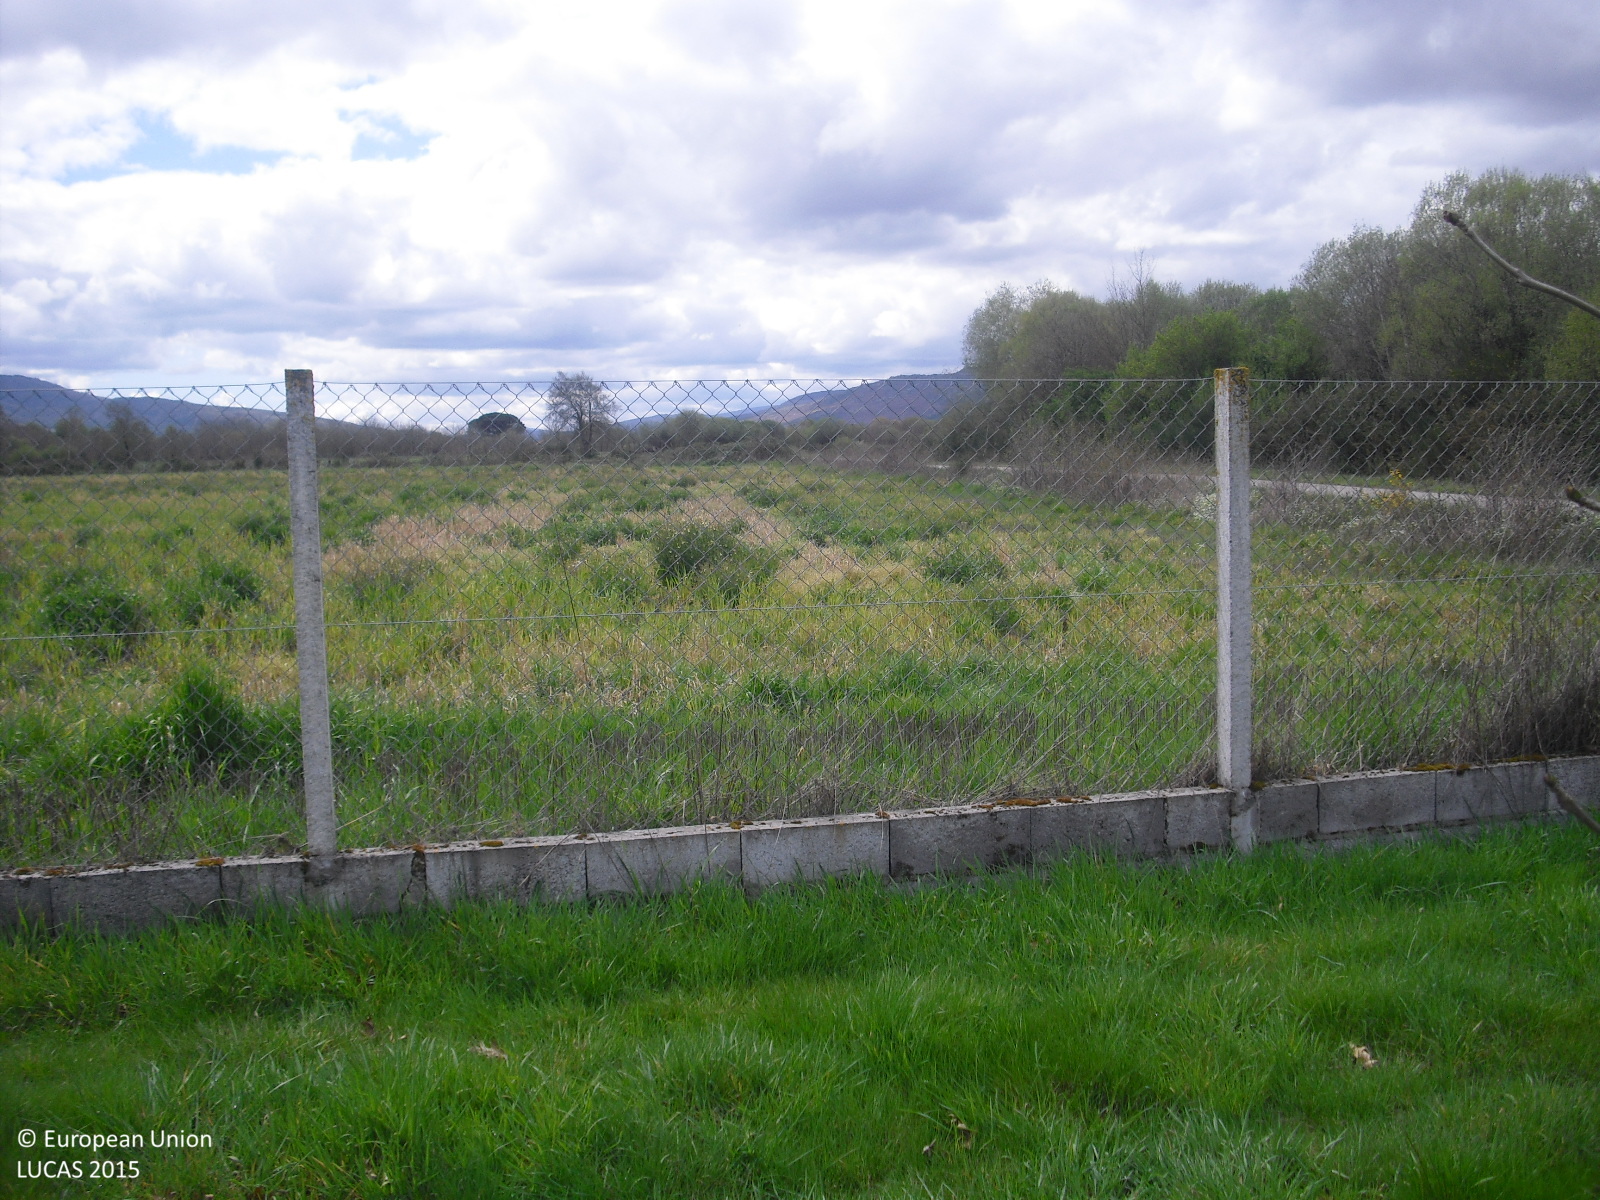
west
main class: Woodland
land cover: Broadleaved woodland
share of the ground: 10 - 25 %
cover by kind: herbaceous plants 80 %, broadleaved forest trees 20 %
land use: Forestry
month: April
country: ES
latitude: 42.0371
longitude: -7.8168
